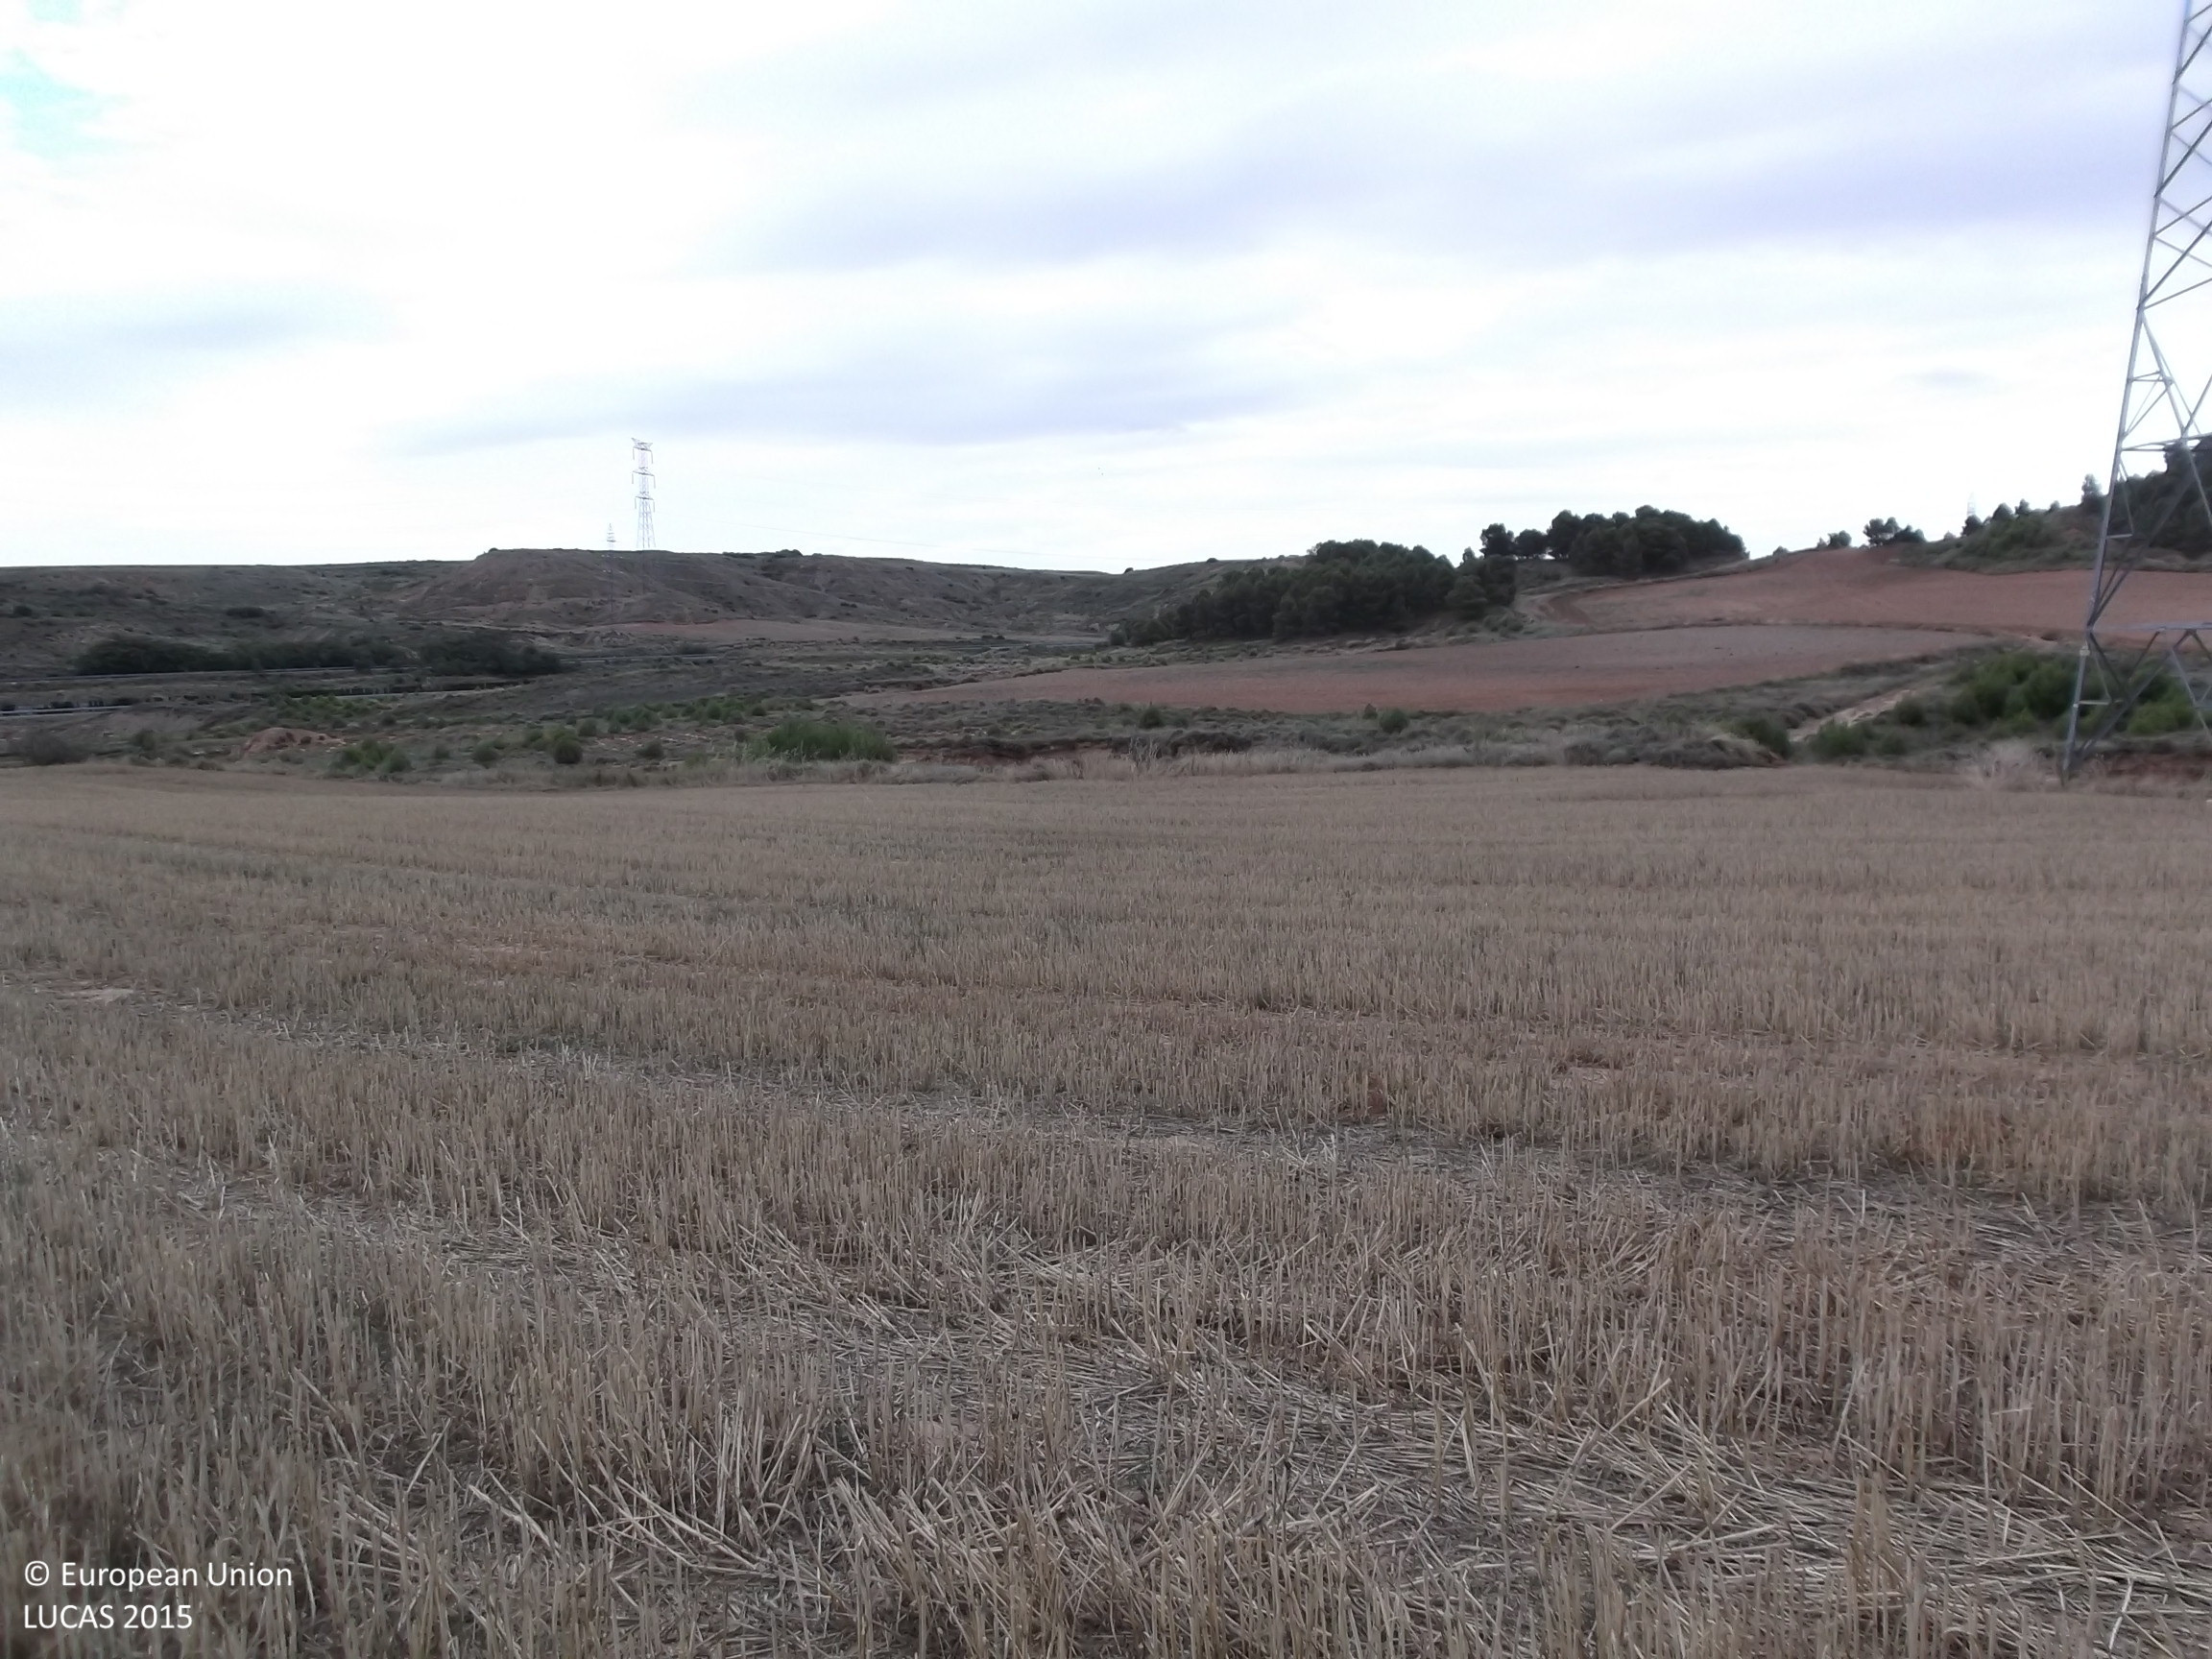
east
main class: Cropland
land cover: Common wheat
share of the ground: < 10 %
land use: Agriculture (excluding fallow land and kitchen gardens)
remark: Harvested field
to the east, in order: Common wheat; Electric lines; Common wheat; Shrubland without tree cover; Other bare soil; Spontaneously vegetated surfaces; Grassland without tree/shrub cover; Shrubland with sparse tree cover
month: July
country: ES
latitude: 42.3998
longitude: -2.2518
